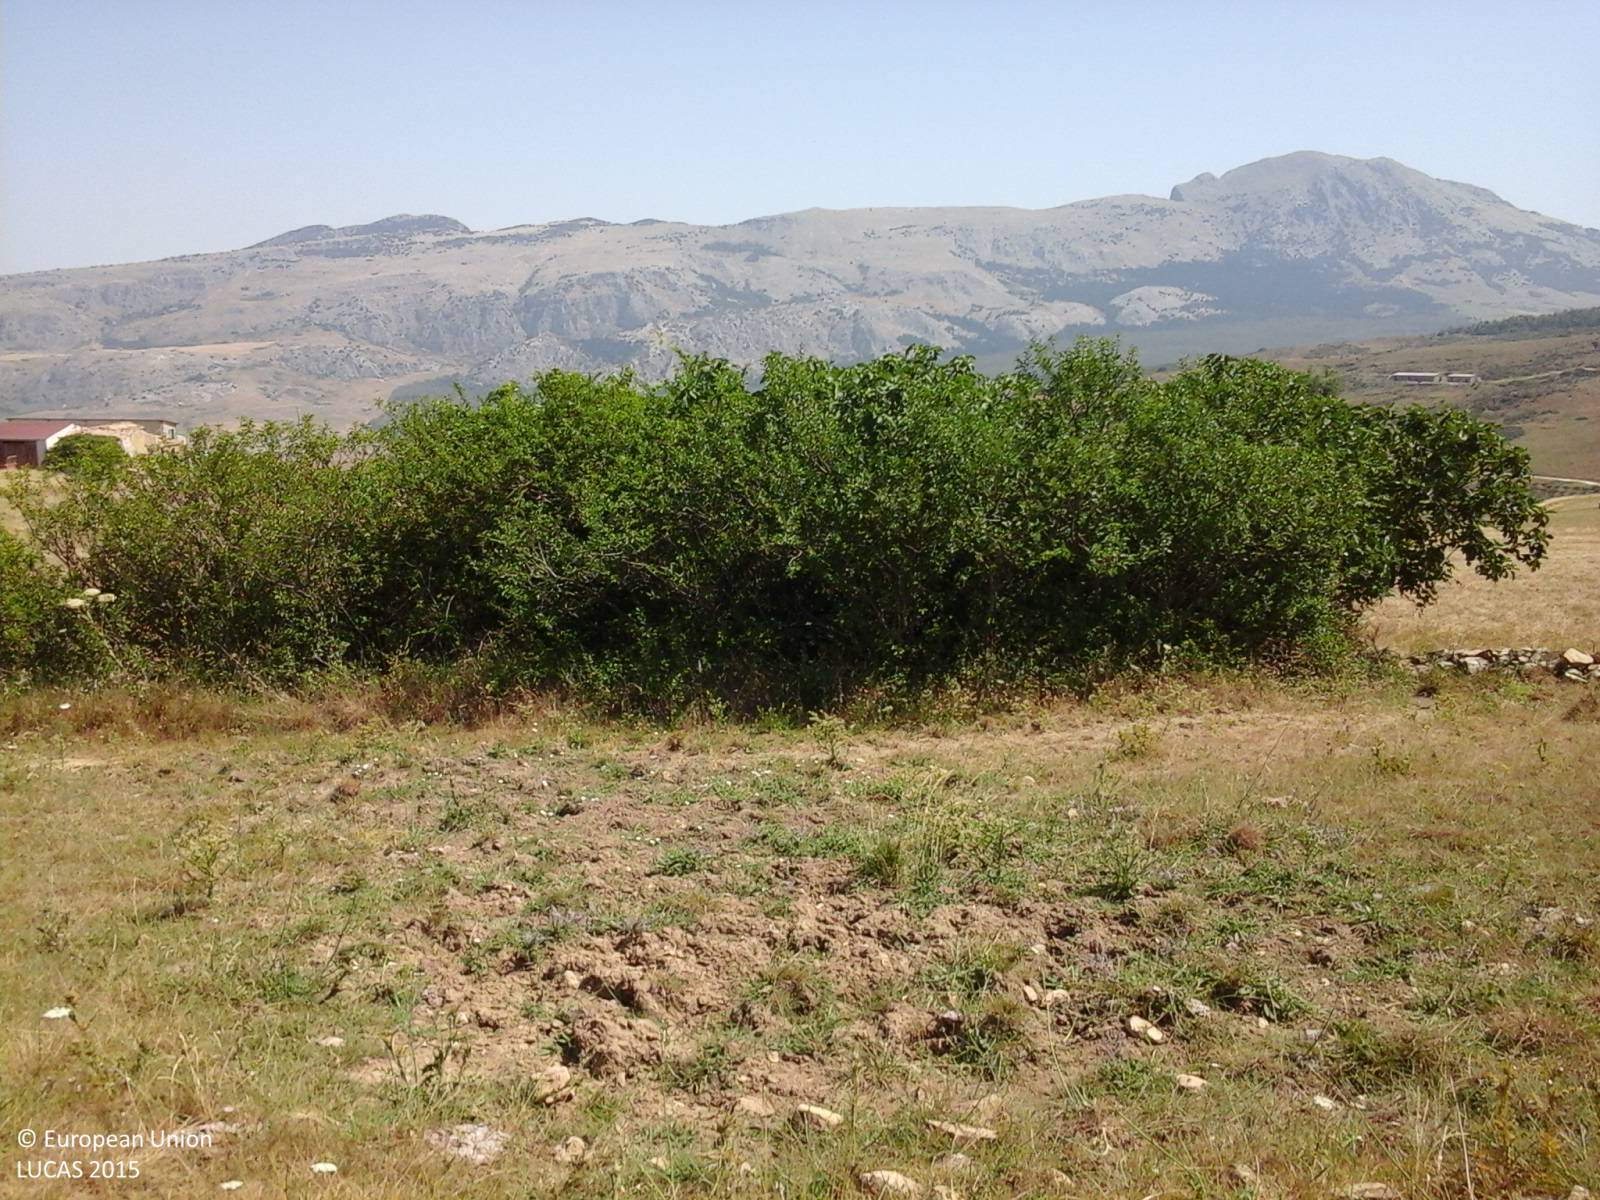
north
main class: Grassland
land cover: Grassland without tree/shrub cover
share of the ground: > 75 %
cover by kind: herbaceous plants 100 %
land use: Agriculture (excluding fallow land and kitchen gardens)
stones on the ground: < 10 %
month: July
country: IT
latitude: 37.8157
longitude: 13.3493
